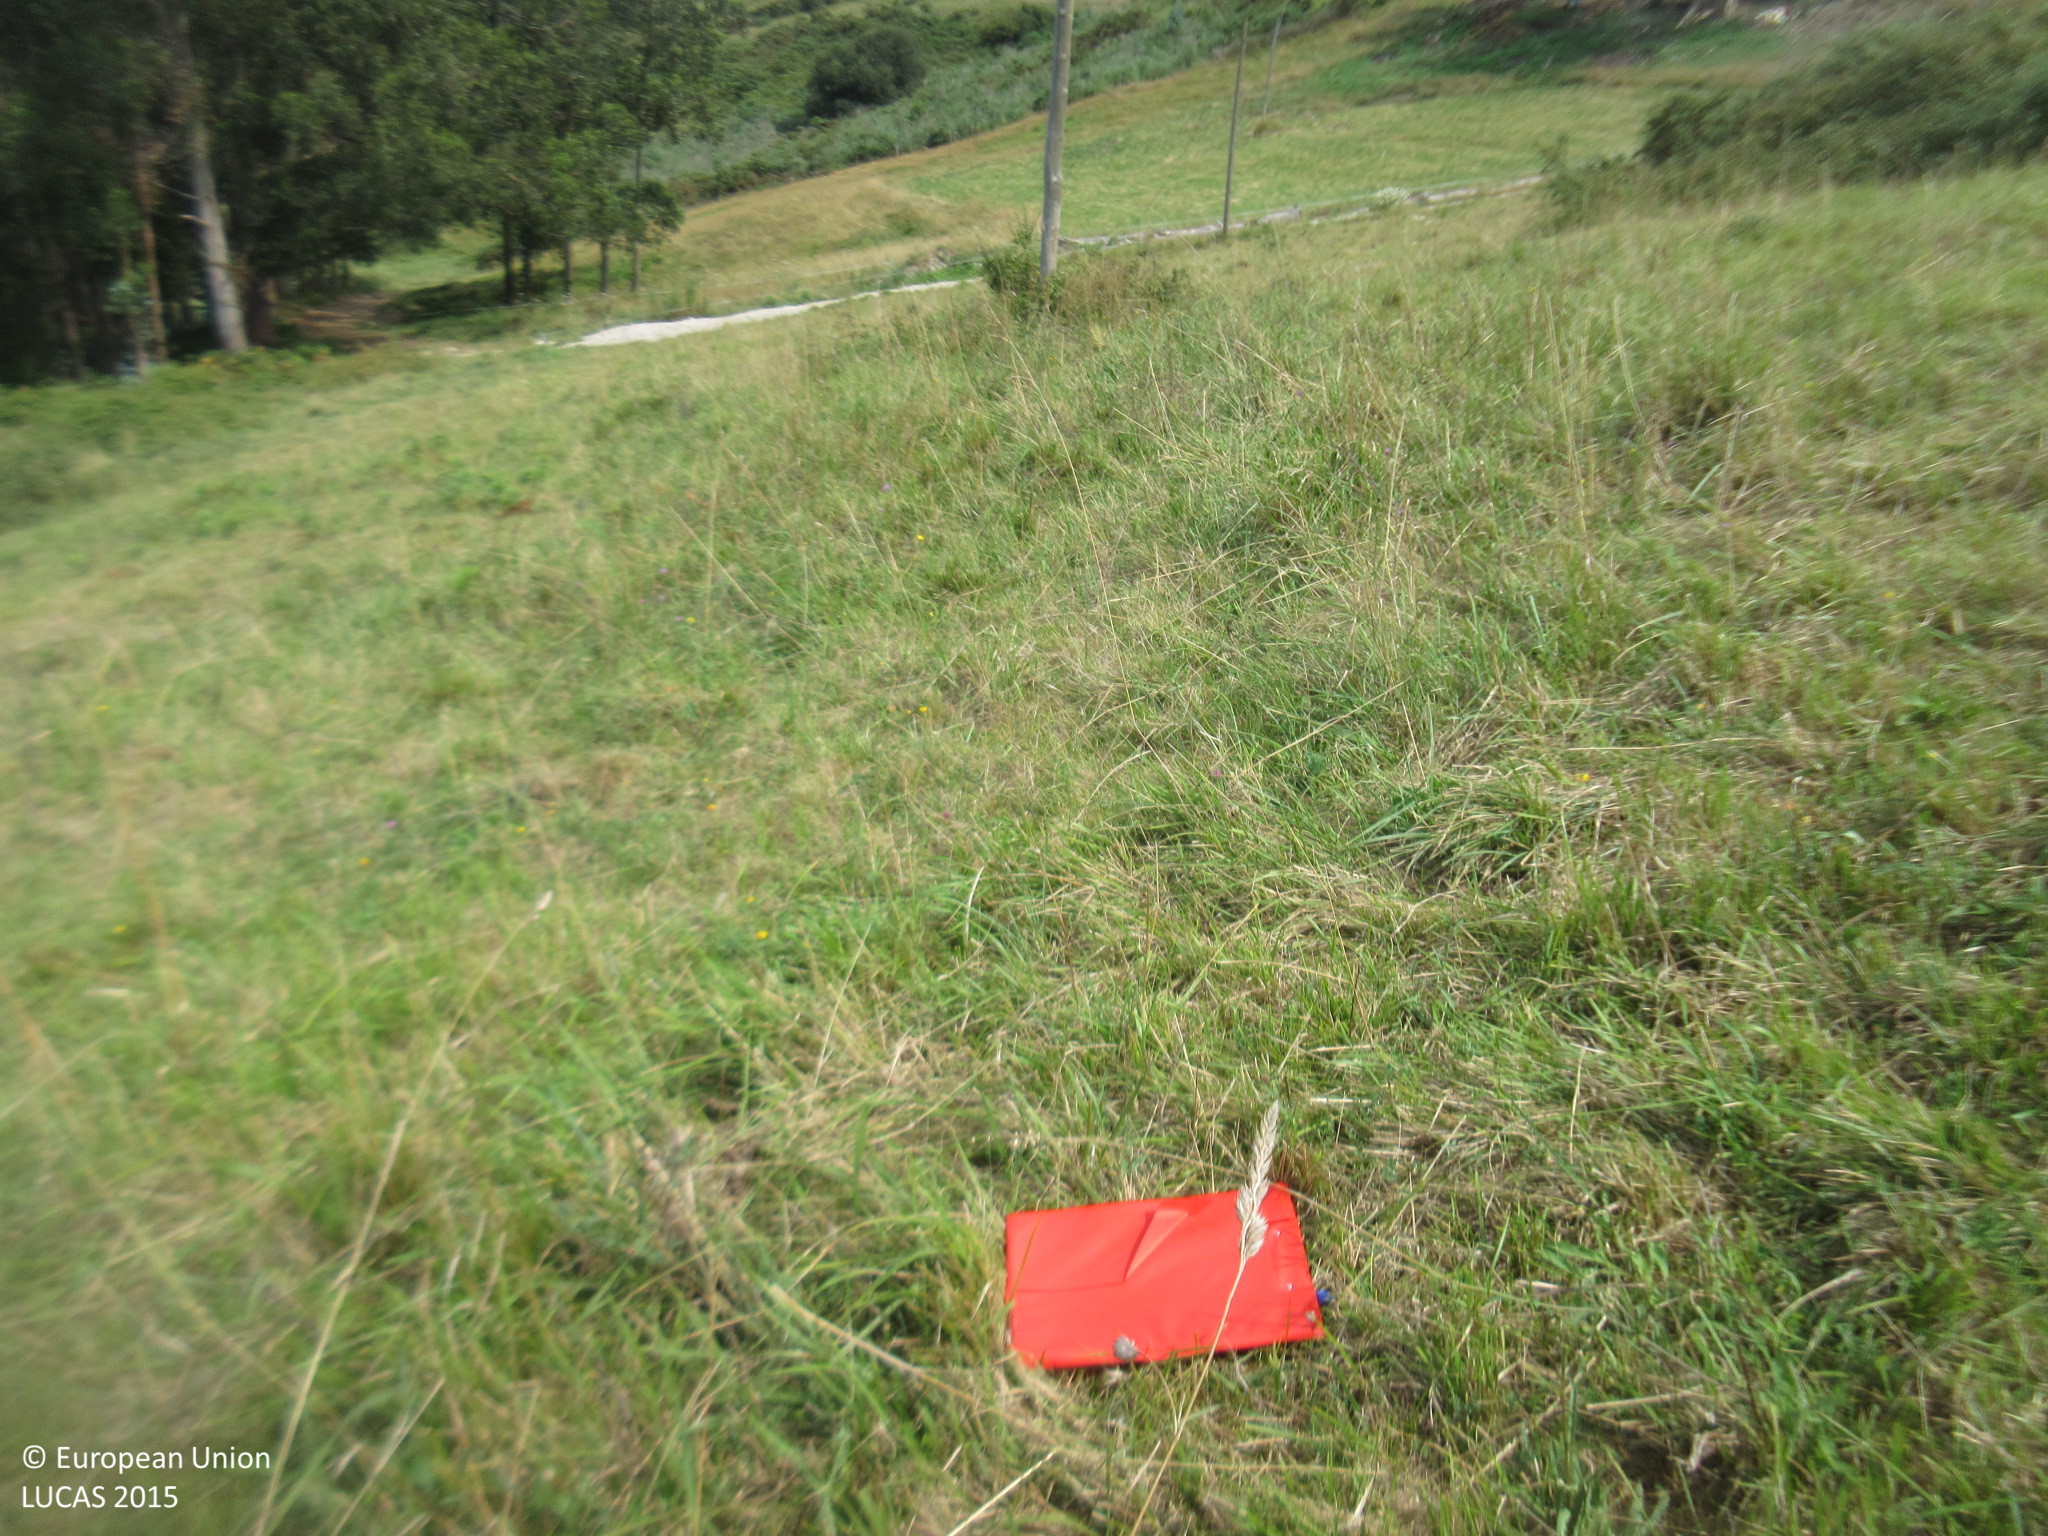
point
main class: Grassland
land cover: Grassland without tree/shrub cover
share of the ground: > 75 %
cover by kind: herbaceous plants 100 %
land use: Agriculture (excluding fallow land and kitchen gardens)
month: July
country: ES
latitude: 43.4394
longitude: -3.9509
